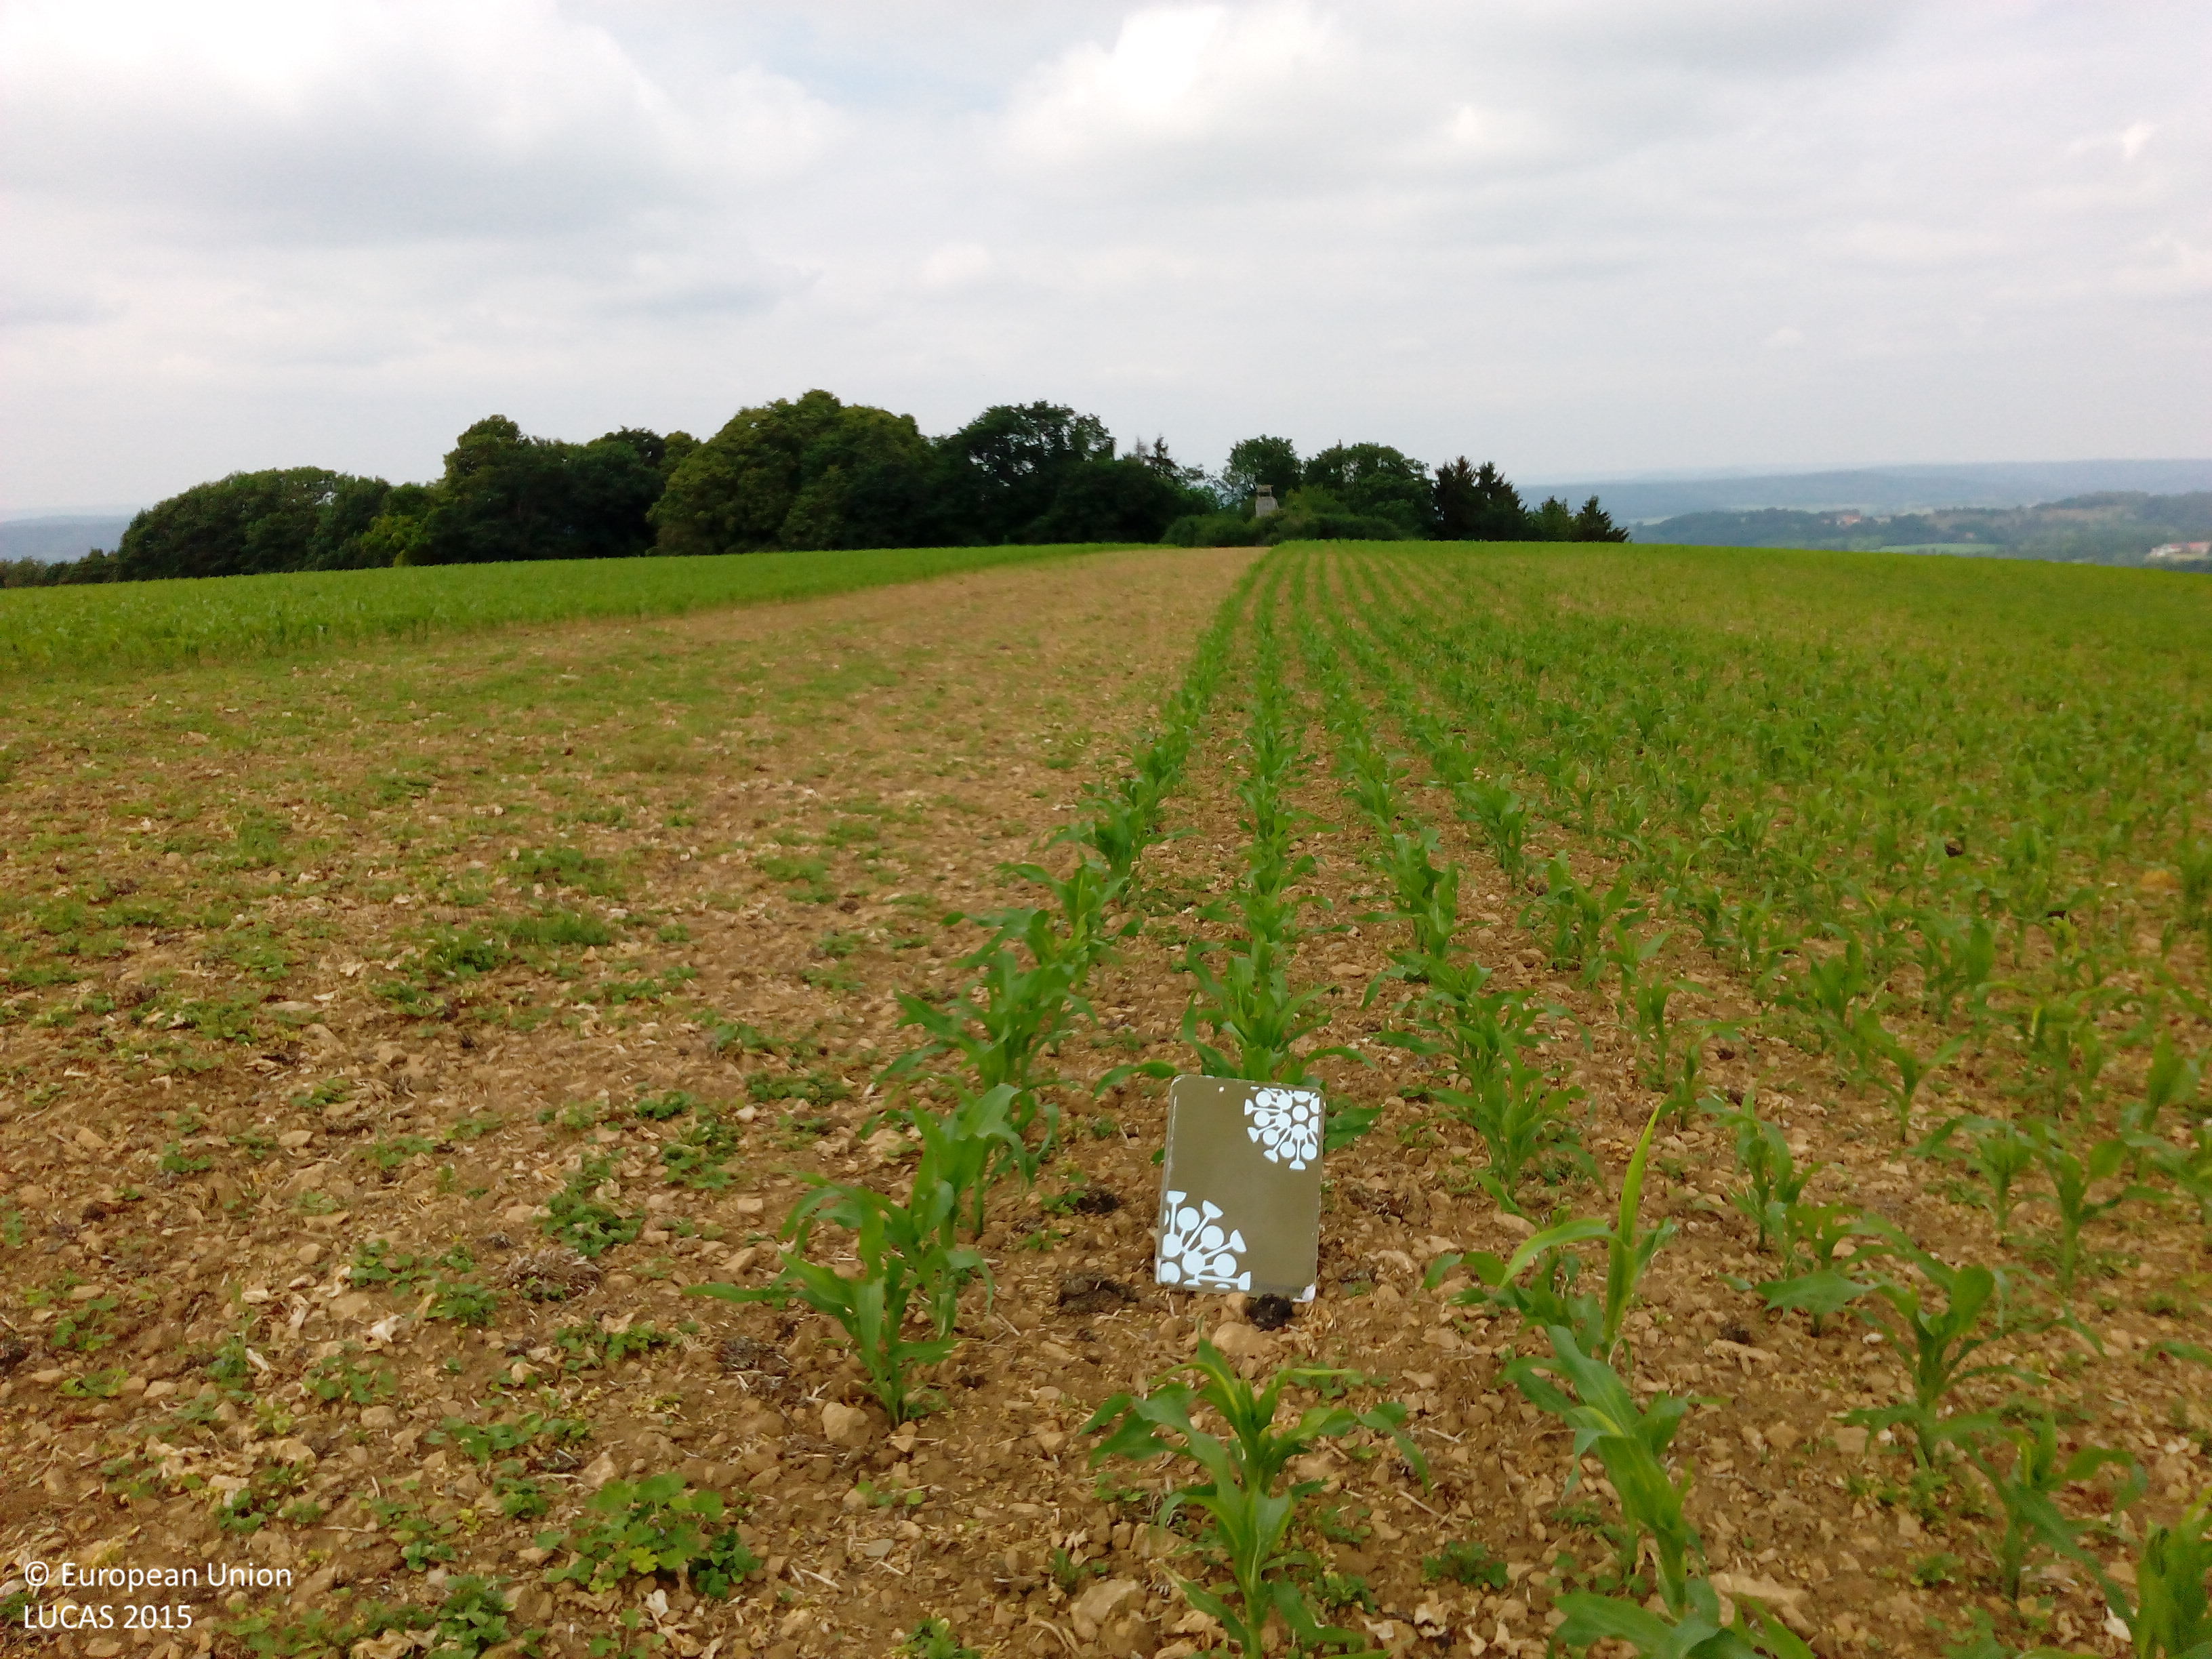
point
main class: Cropland
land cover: Maize
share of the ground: 25 - 50 %
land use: Agriculture (excluding fallow land and kitchen gardens)
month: June
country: DE
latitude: 50.6414
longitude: 11.5410
